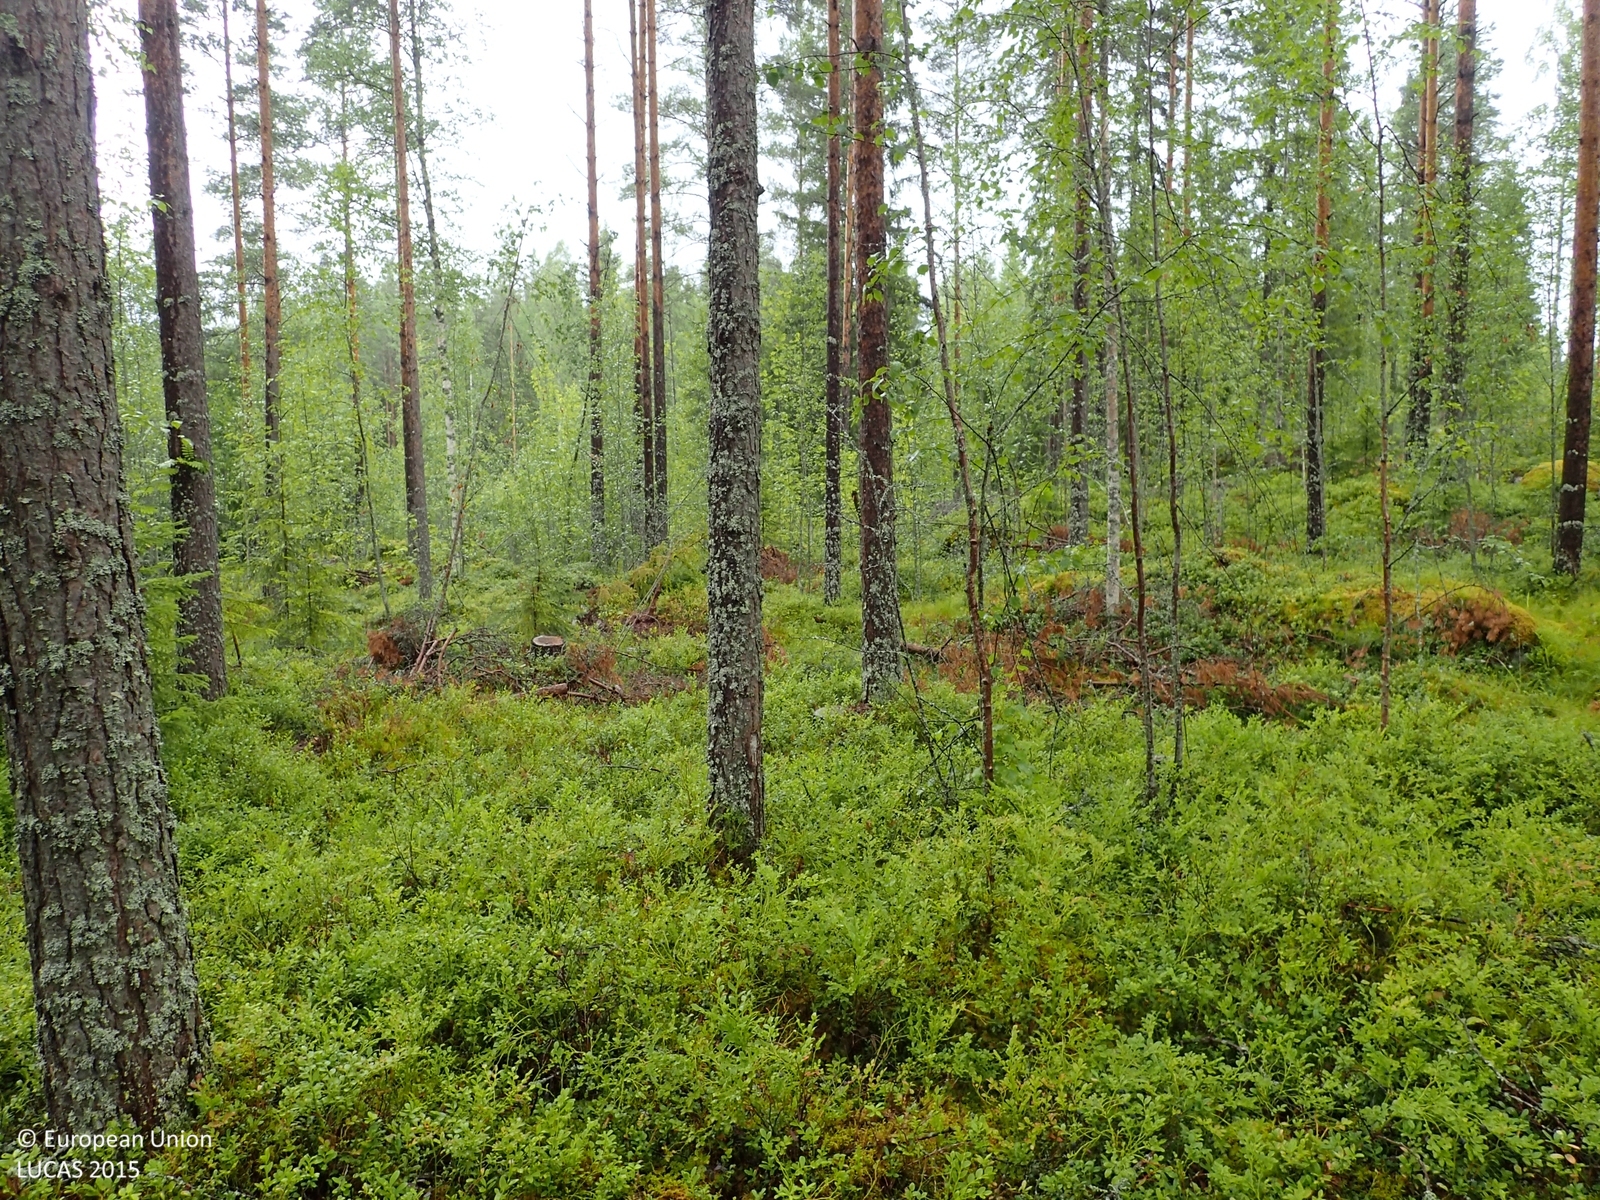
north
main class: Woodland
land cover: Pine dominated coniferous woodland
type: boreal forest
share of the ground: 50 - 75 %
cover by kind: coniferous forest trees 45 %, shrubs 40 %, broadleaved forest trees 10 %, lichens and mosses 5 %
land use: Forestry
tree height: > 5 m
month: July
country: FI
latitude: 63.0193
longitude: 22.7585
